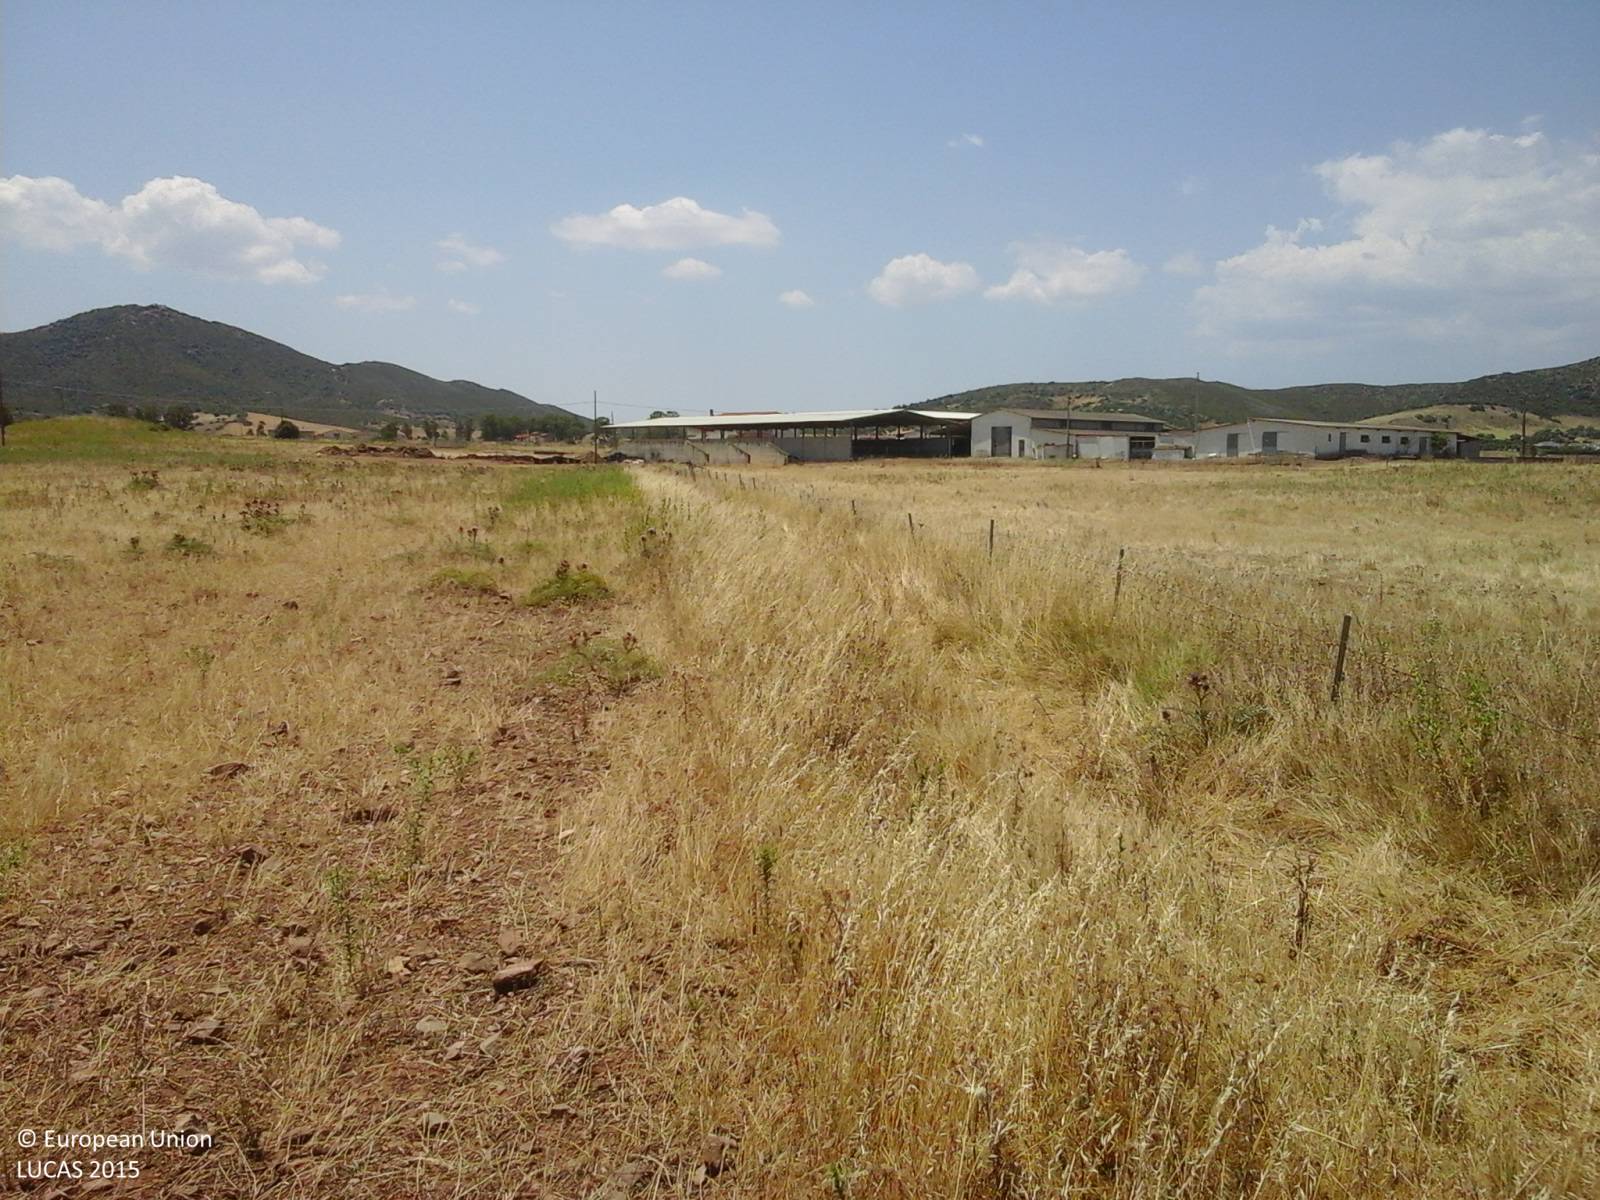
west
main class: Grassland
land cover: Spontaneously vegetated surfaces
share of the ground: > 75 %
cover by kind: herbaceous plants 85 %, unconsolidated bare surface 15 %
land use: Agriculture (excluding fallow land and kitchen gardens)
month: June
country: IT
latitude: 39.3369
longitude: 8.8584
